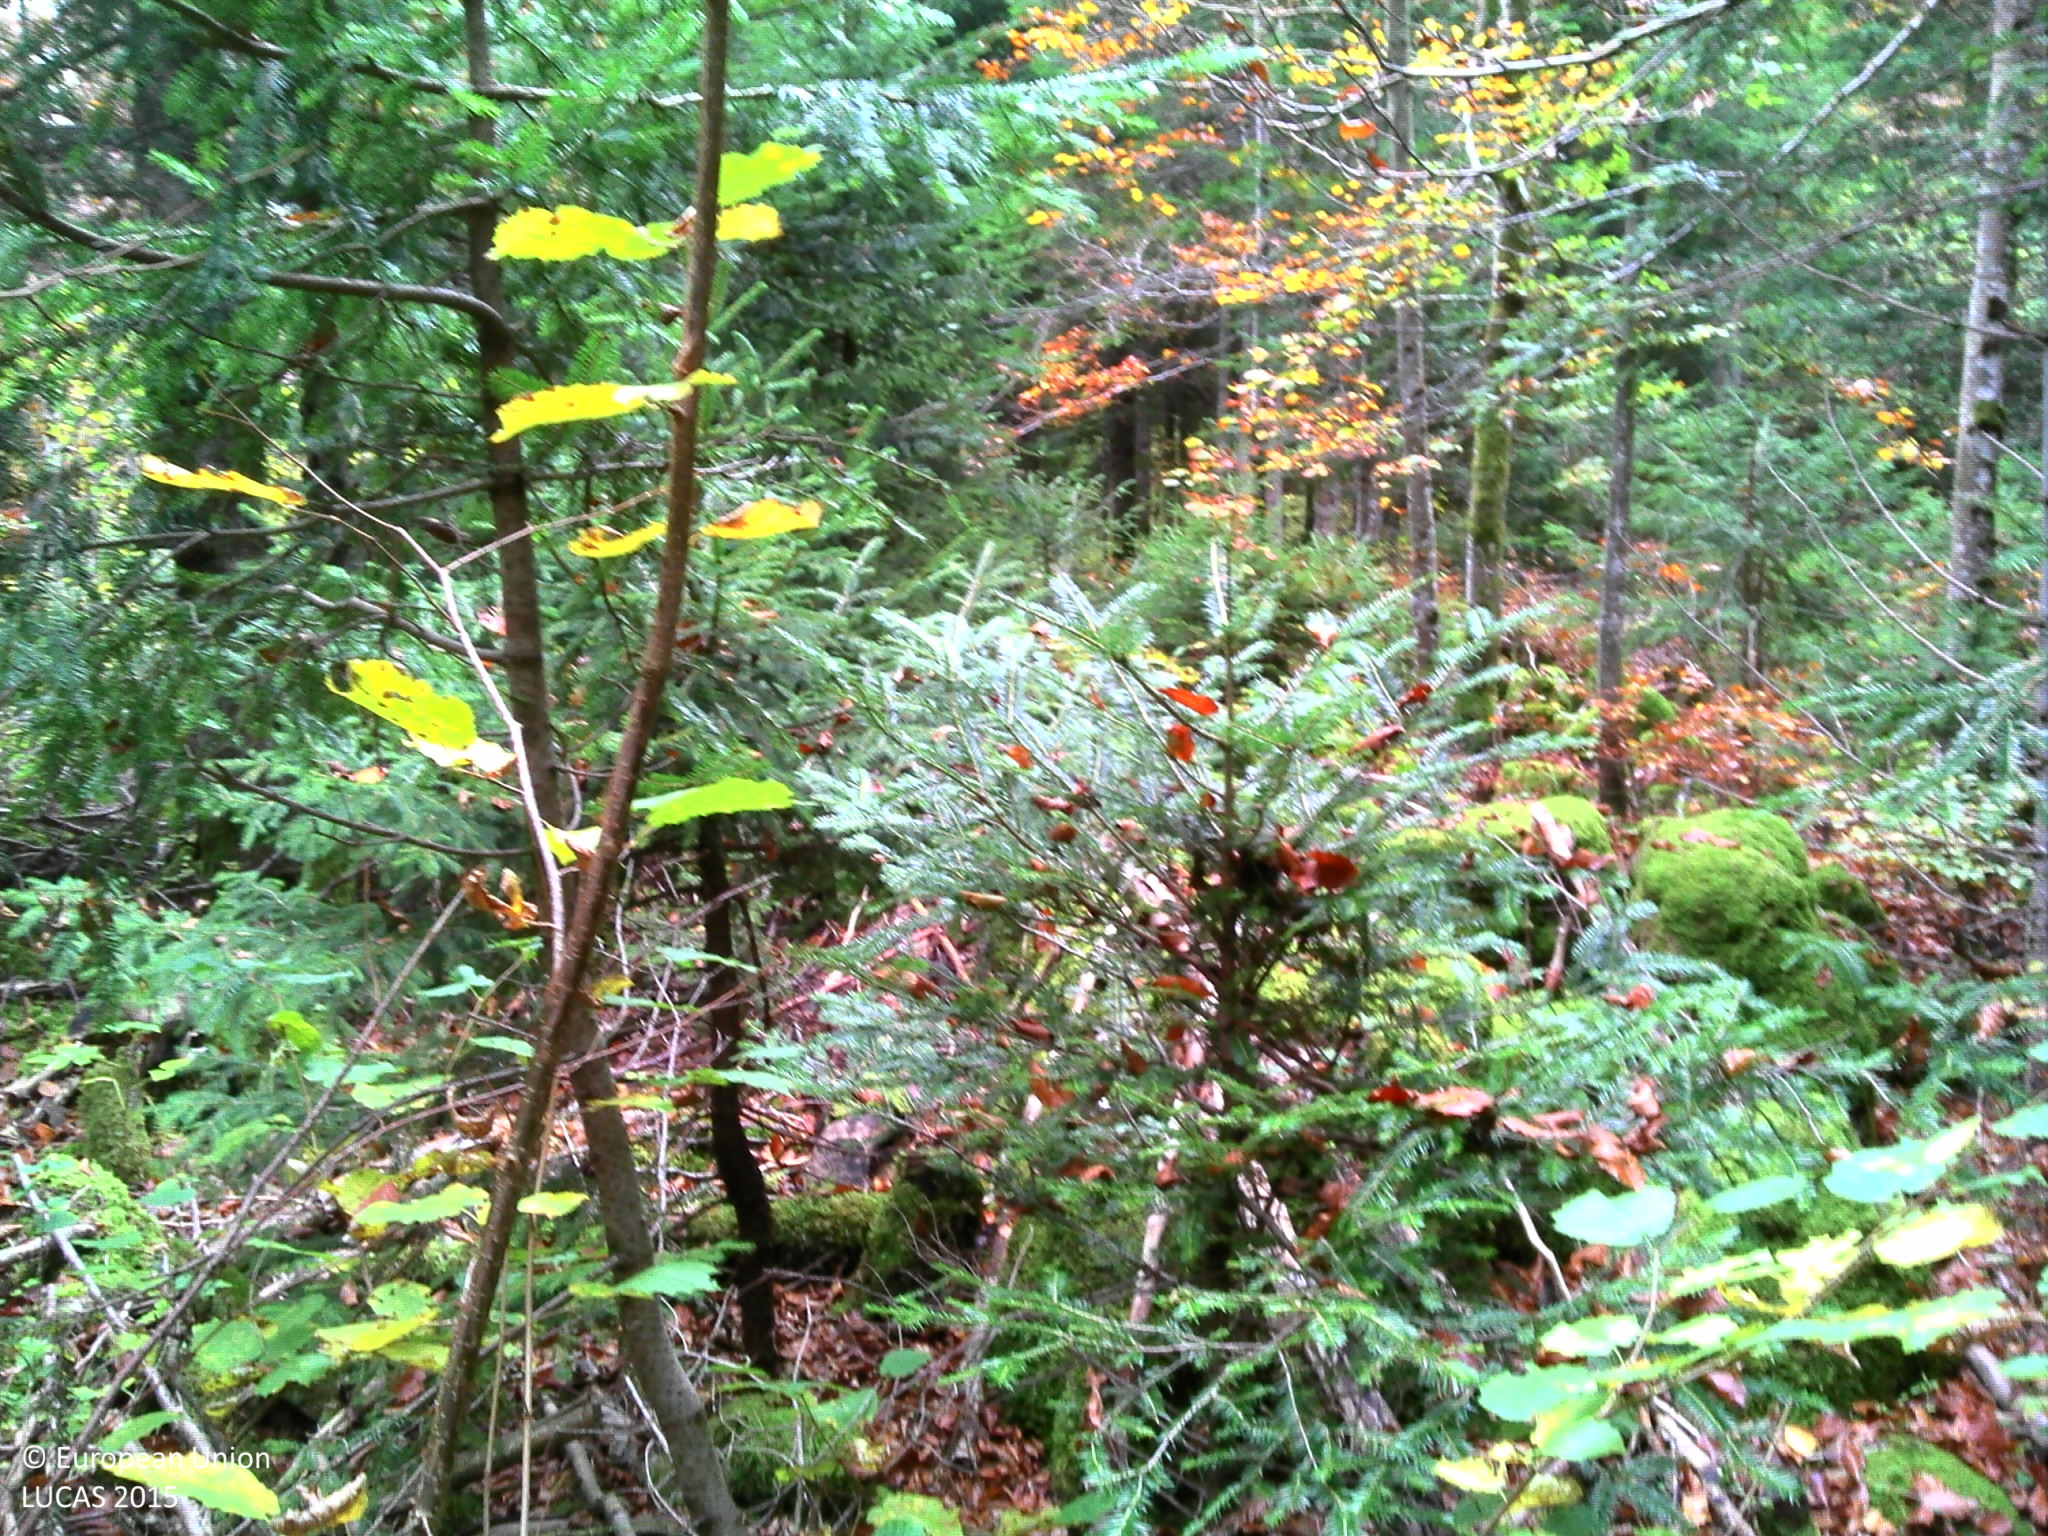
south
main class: Woodland
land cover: Spruce dominated mixed woodland
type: mountainous beech forest
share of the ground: > 75 %
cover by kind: coniferous forest trees 40 %, broadleaved forest trees 40 %, unconsolidated bare surface 10 %, lichens and mosses 5 %, consolidated bare surface 5 %
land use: Forestry
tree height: > 5 m
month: October
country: FR
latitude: 46.6964
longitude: 6.1448
